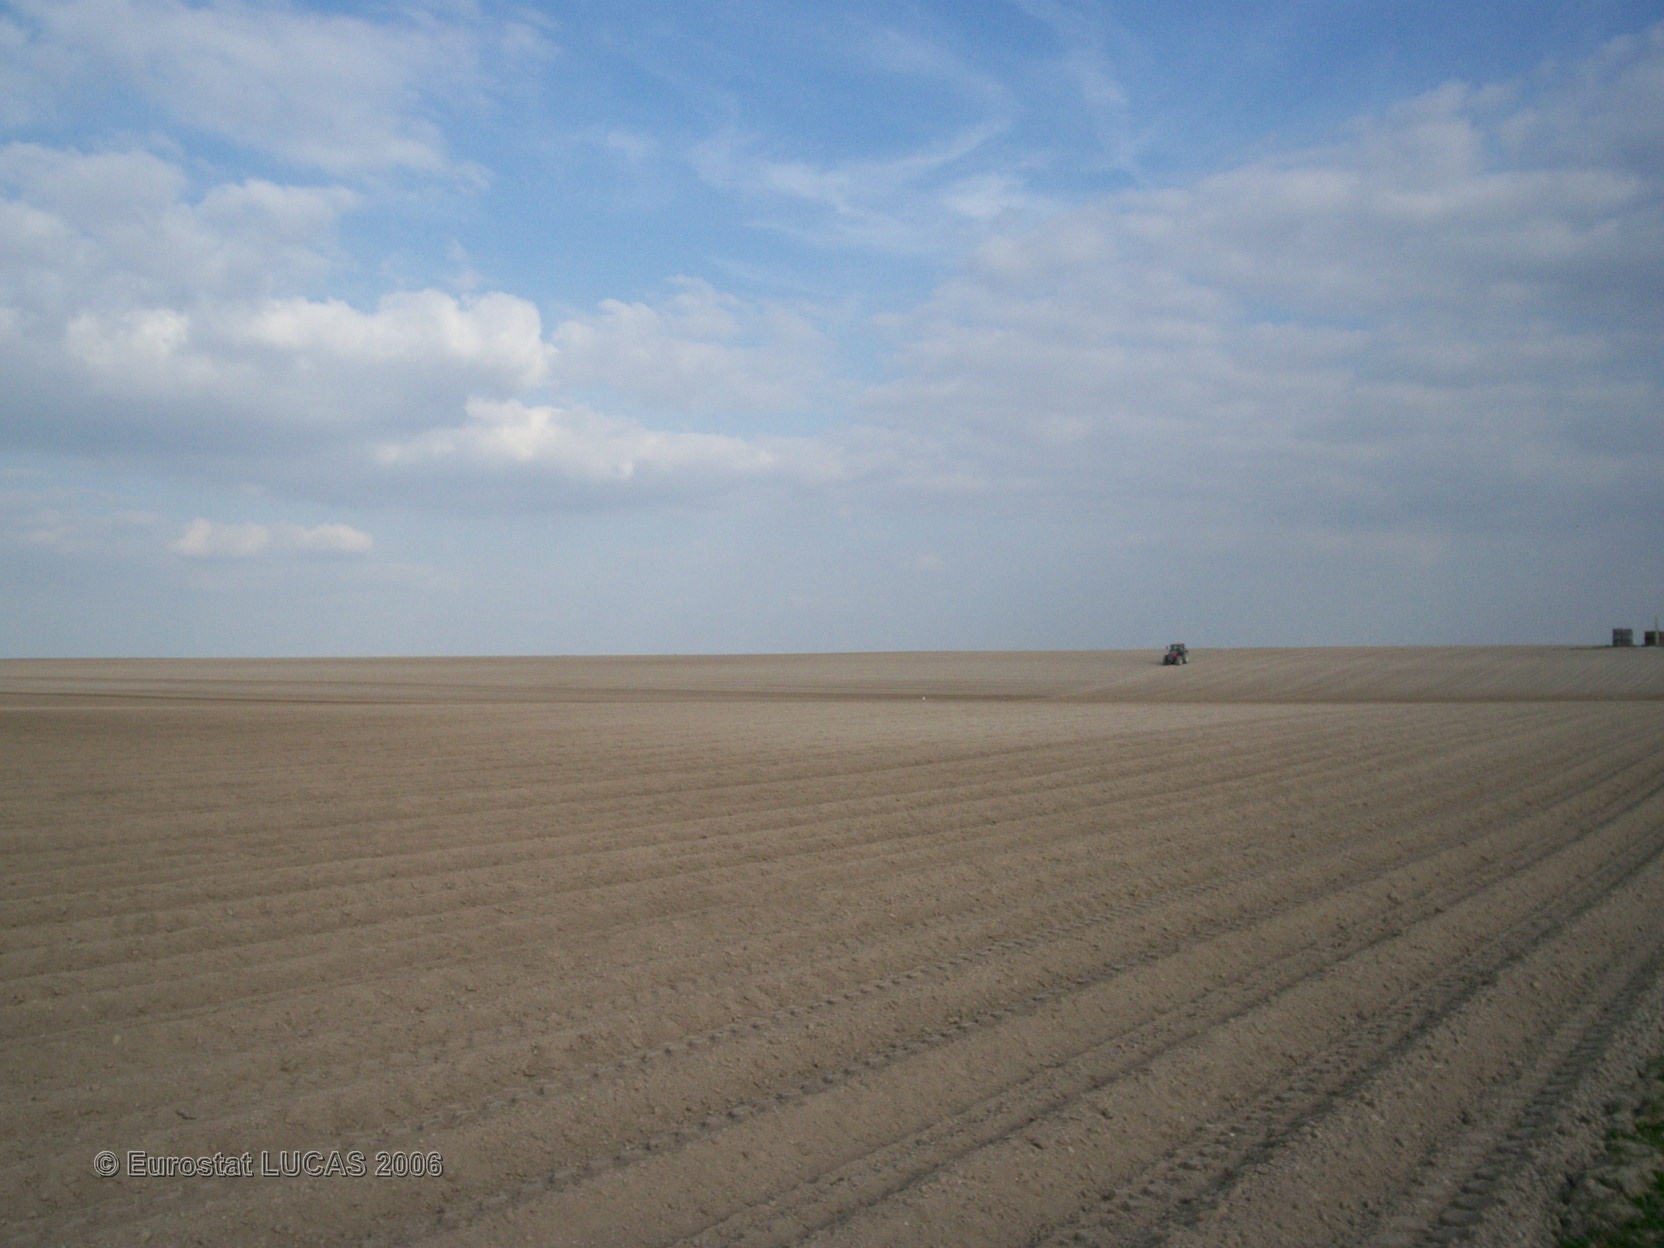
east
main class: Cropland
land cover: Potatoes
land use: Agriculture (excluding fallow land and kitchen gardens)
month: April
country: FR
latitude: 48.7591
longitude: 3.9145
